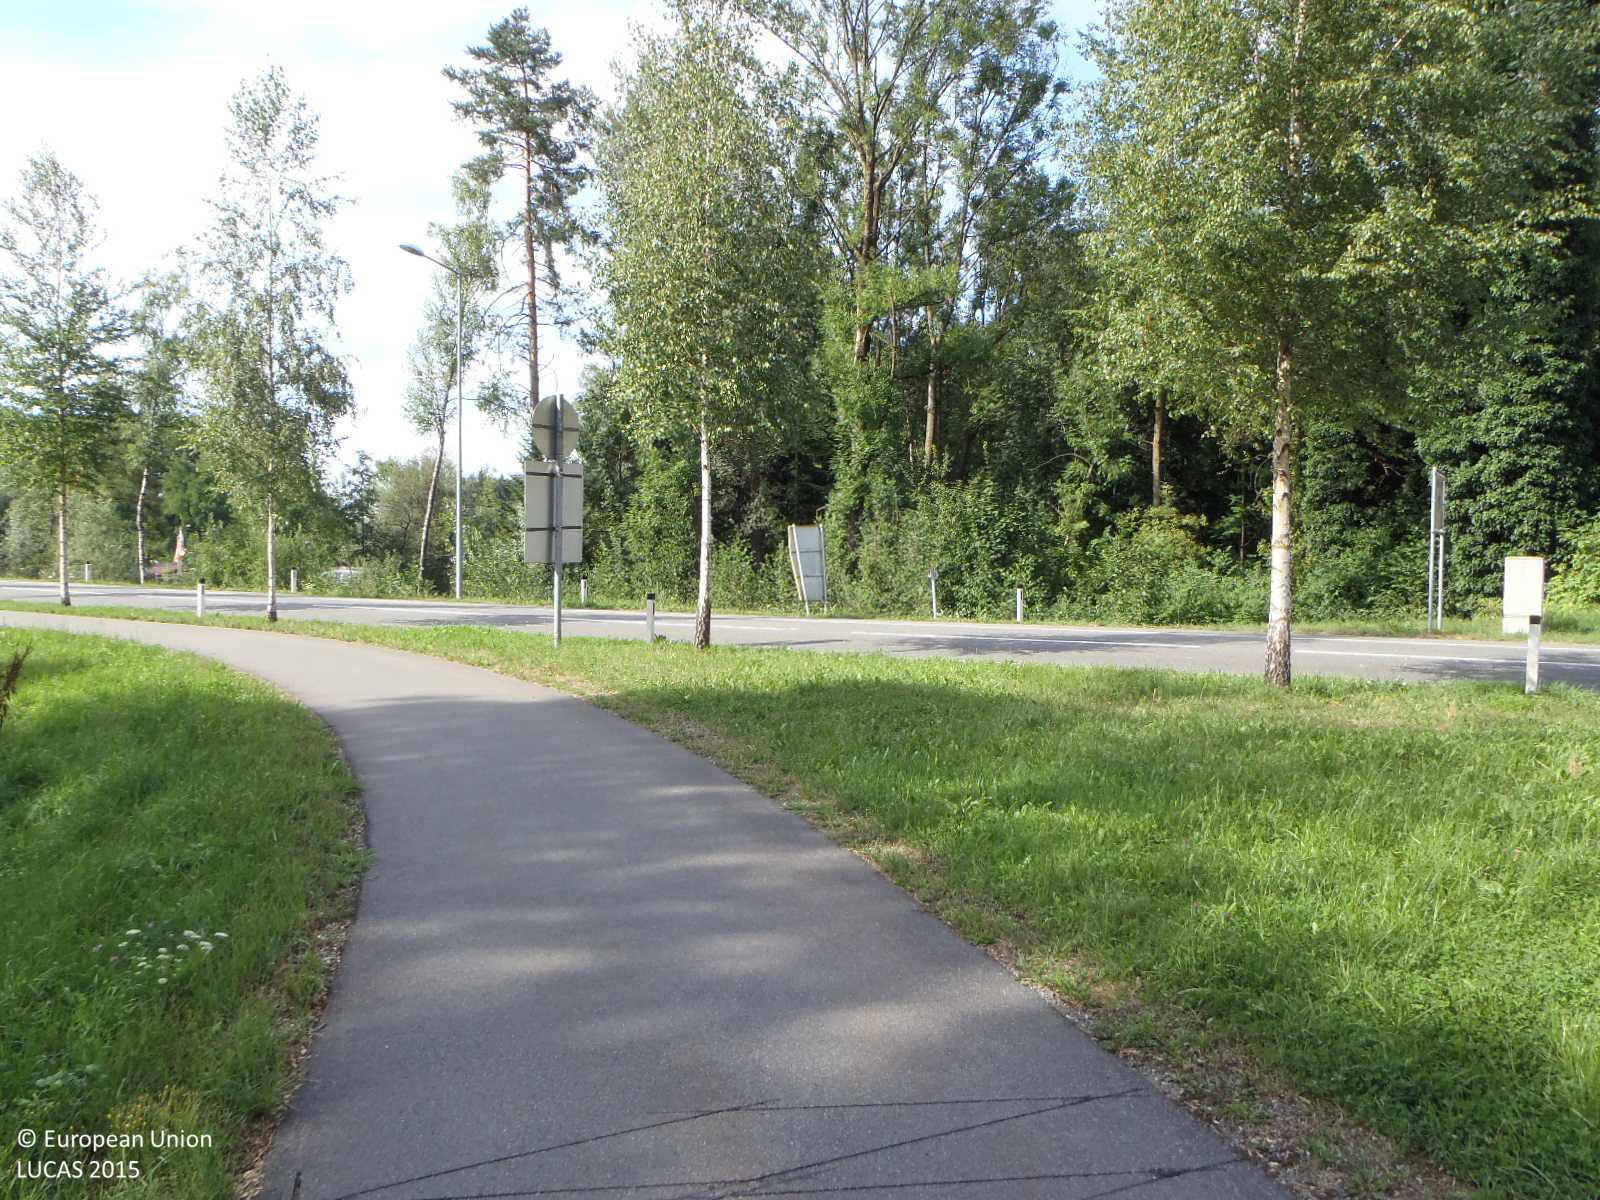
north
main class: Woodland
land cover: Other mixed woodland
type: alpine coniferous forest
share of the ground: > 75 %
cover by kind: coniferous forest trees 50 %, broadleaved forest trees 50 %
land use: Semi-natural and natural areas not in use
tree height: > 5 m
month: July
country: CH
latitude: 47.3771
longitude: 9.6692
